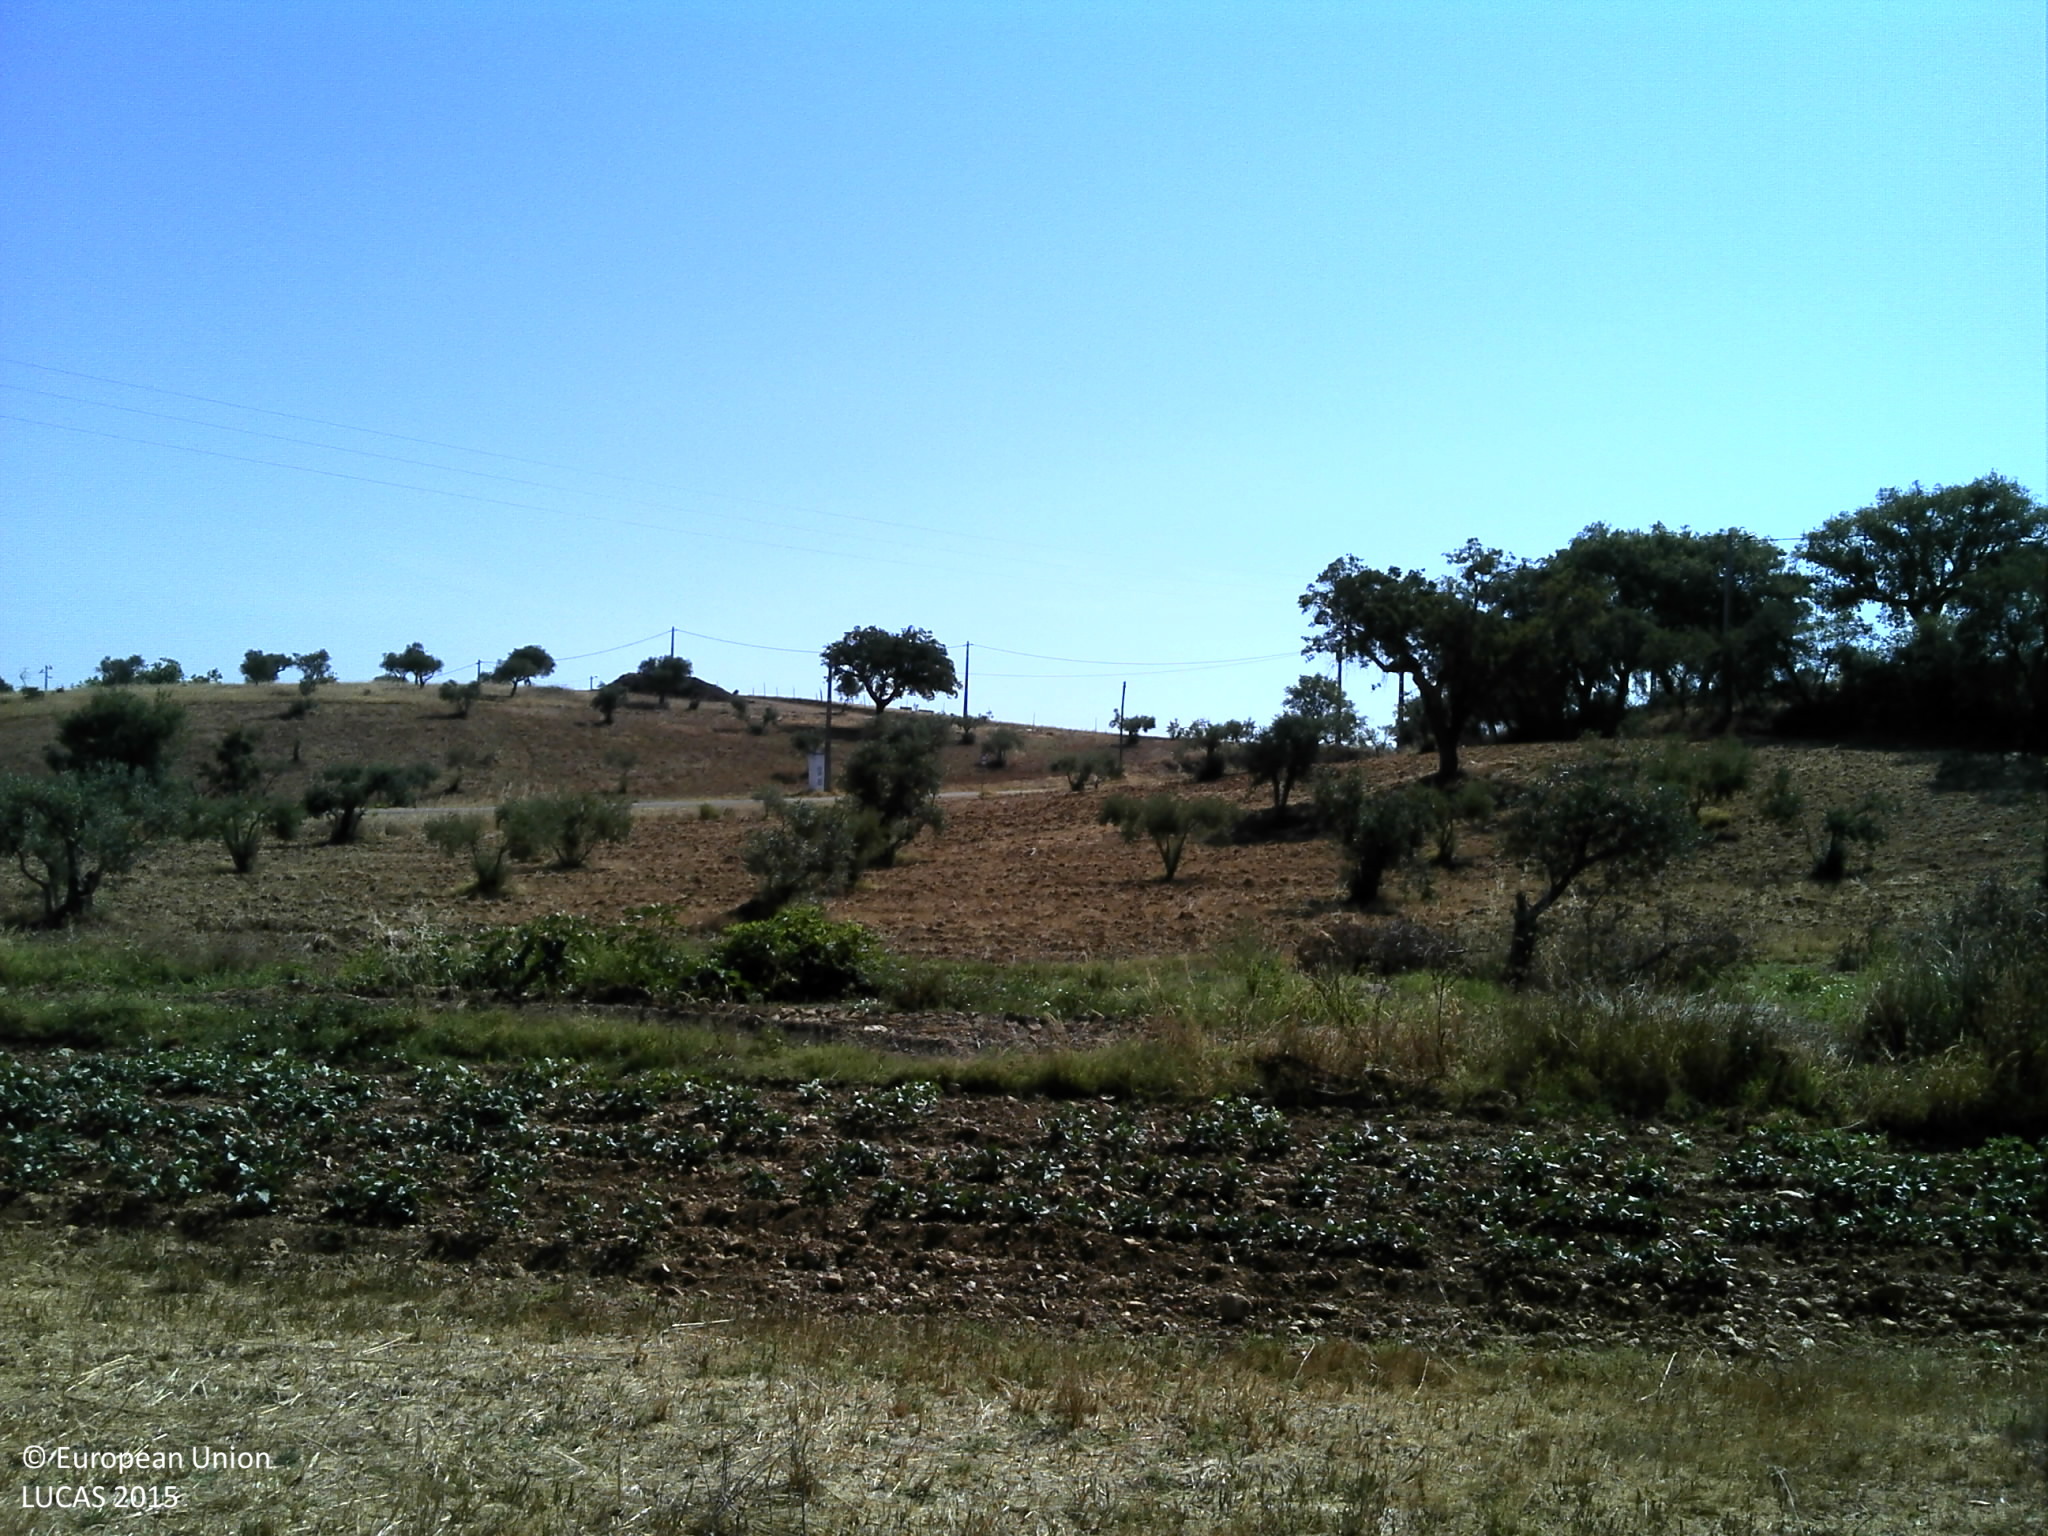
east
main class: Cropland
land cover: Olive groves
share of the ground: 10 - 25 %
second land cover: Oats
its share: < 10 %
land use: Agriculture (excluding fallow land and kitchen gardens)
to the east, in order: Olive groves; Oats; Other bare soil; Grass margins; Rivers and streams; Grass margins; Olive groves; Abandoned hedges; Tracks; Electric lines; Dry stone walls; Abandoned hedges; Olive groves; Fences; Mixed cereals for fodder; Electric lines; Mixed cereals for fodder; Electric lines; Mixed cereals for fodder; Fences; Ditches and canals; Paved roads, cycling and walking lanes
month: July
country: PT
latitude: 38.5328
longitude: -7.5004
